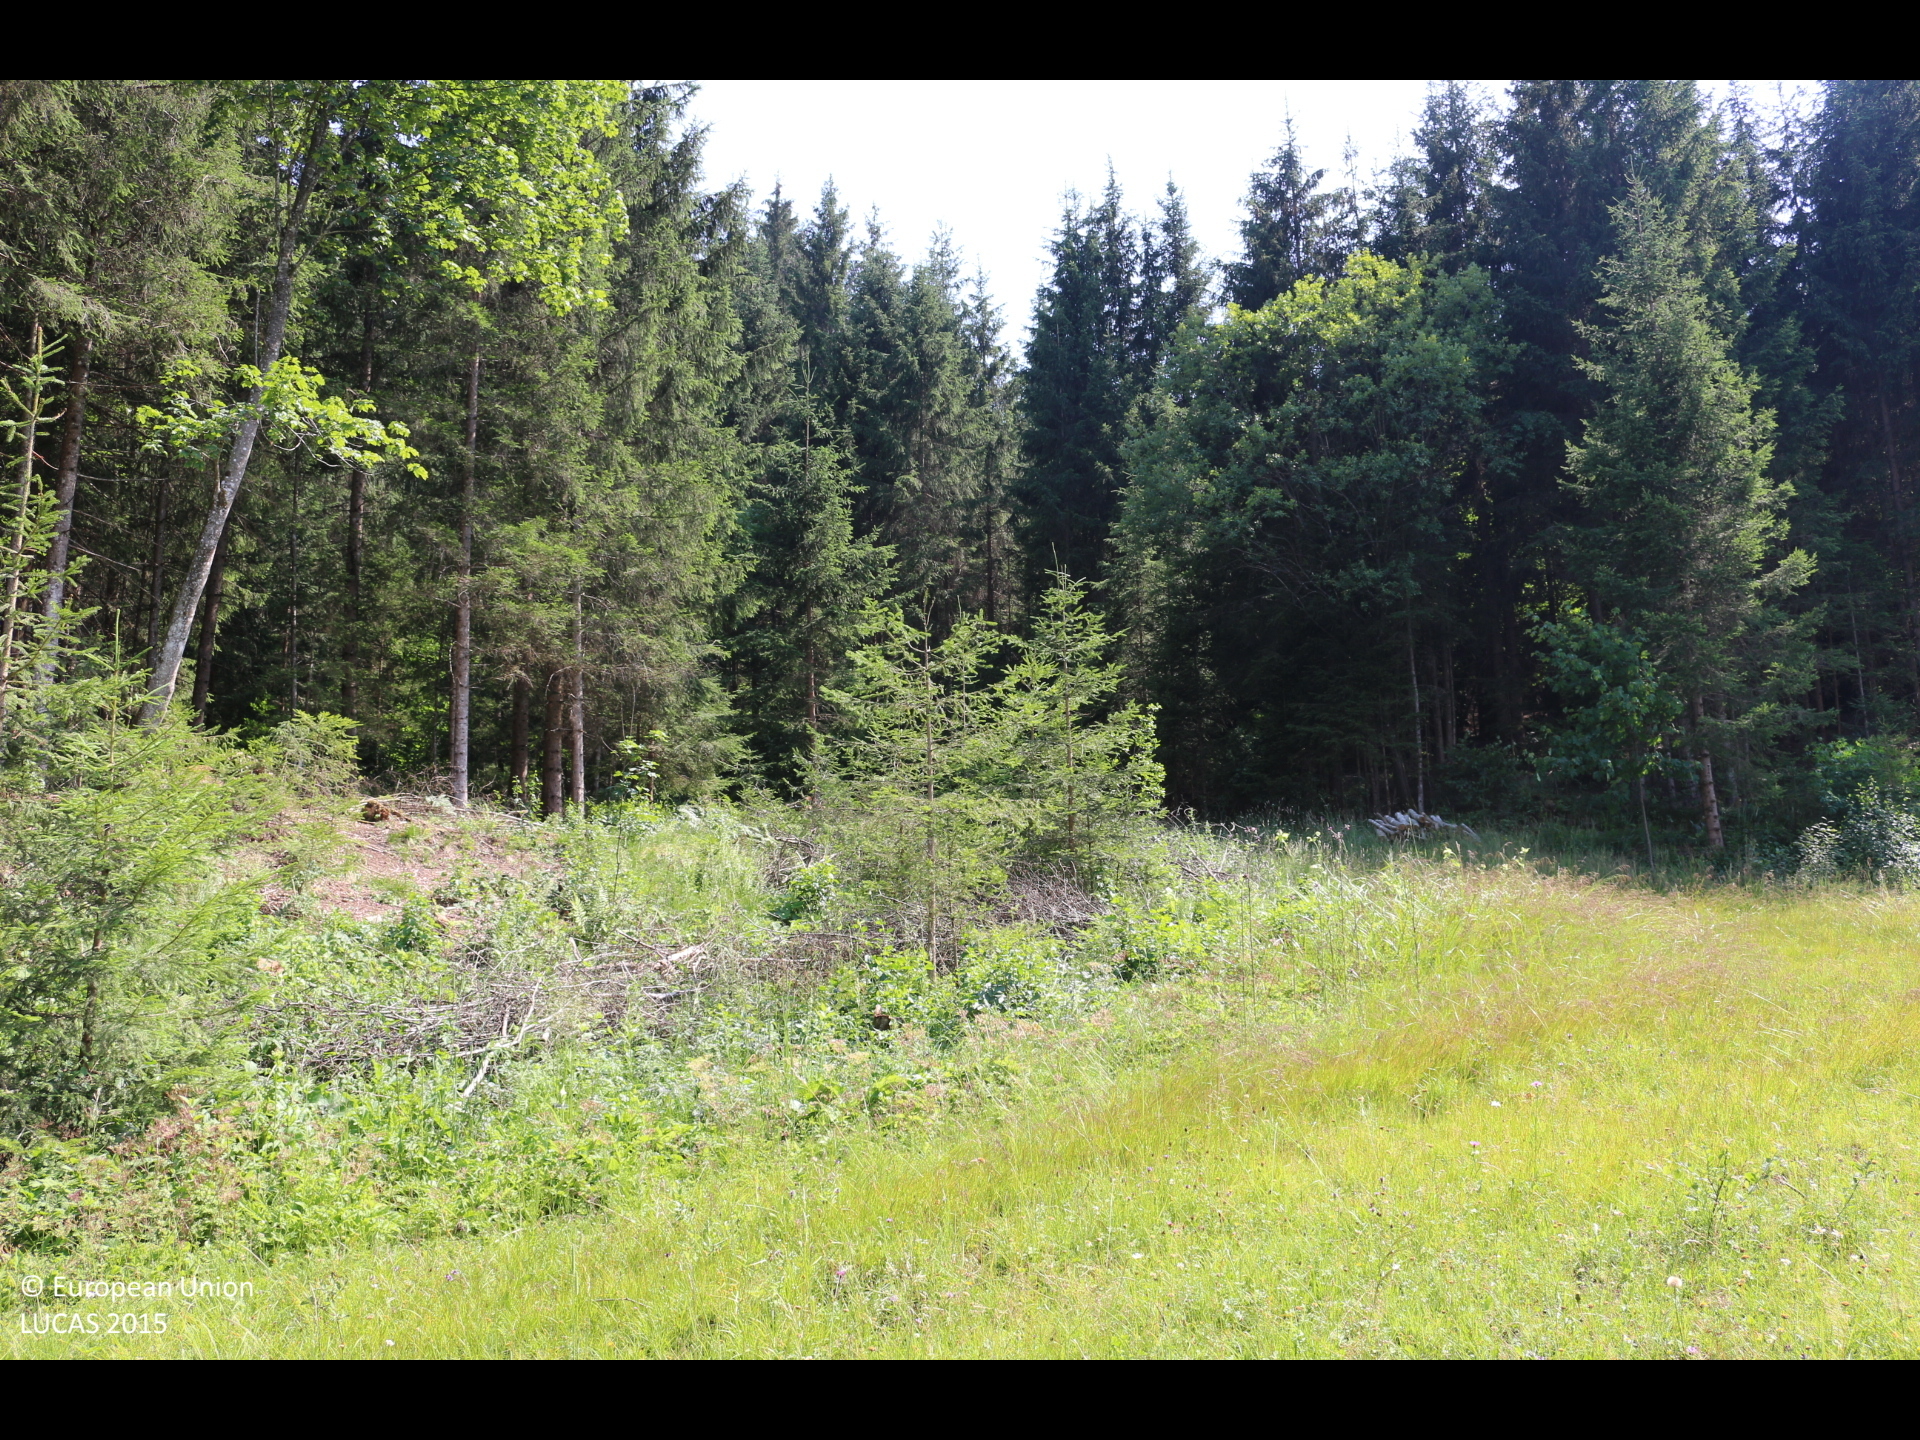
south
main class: Grassland
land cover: Grassland without tree/shrub cover
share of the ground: > 75 %
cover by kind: herbaceous plants 100 %
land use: Agriculture (excluding fallow land and kitchen gardens)
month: July
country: AT
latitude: 46.7777
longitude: 14.0969
